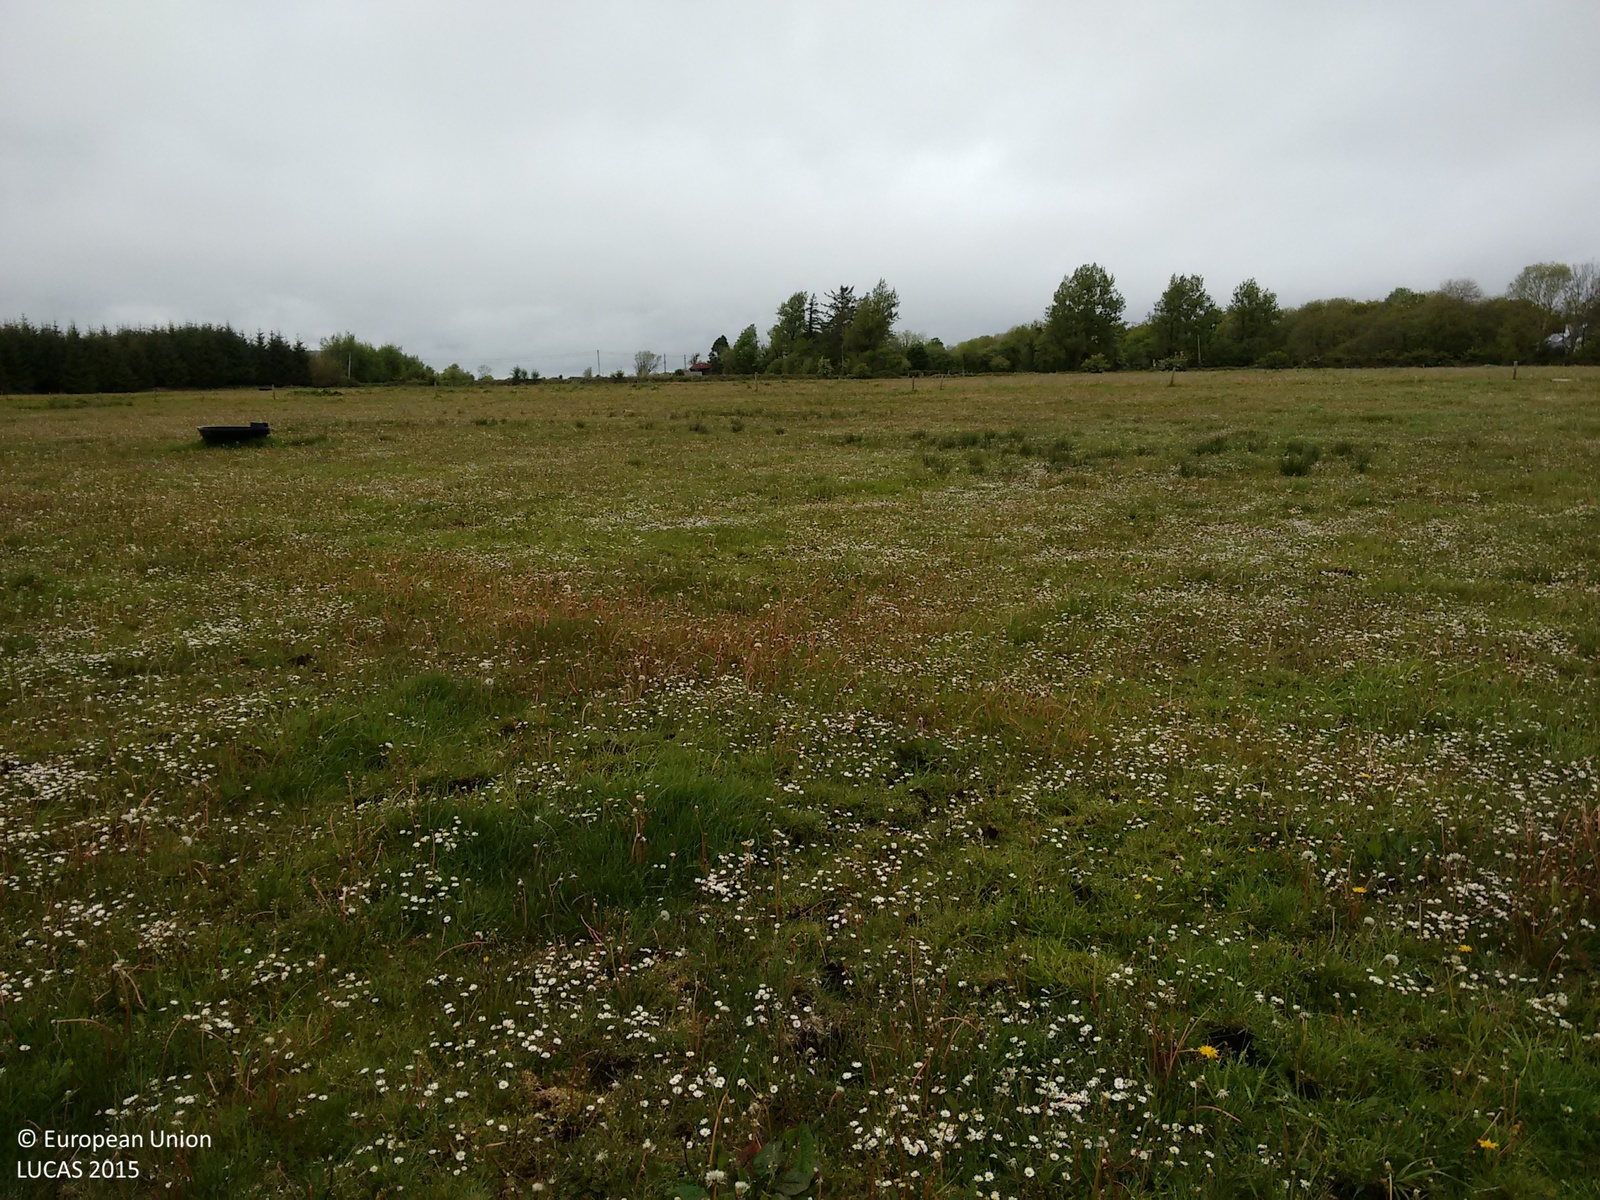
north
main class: Grassland
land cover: Grassland without tree/shrub cover
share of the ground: > 75 %
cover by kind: herbaceous plants 100 %
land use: Agriculture (excluding fallow land and kitchen gardens)
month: May
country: IE
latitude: 53.2939
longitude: -8.6994
